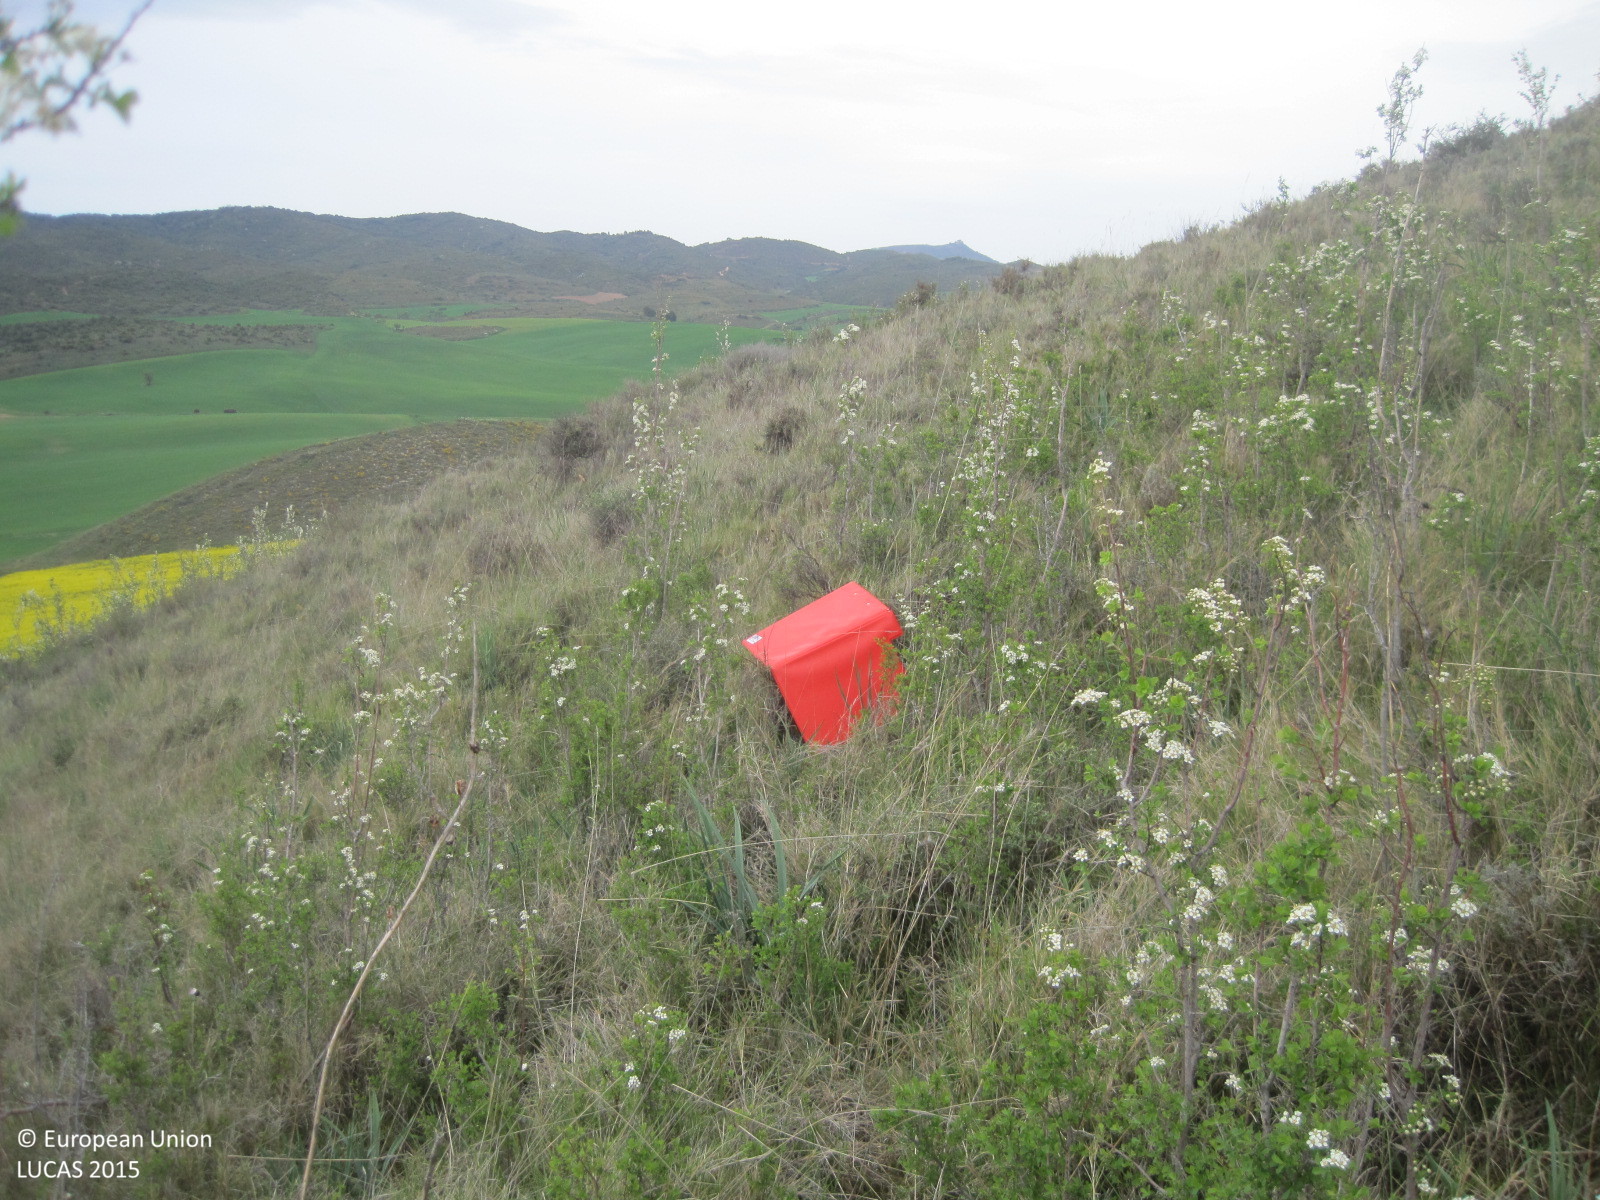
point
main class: Shrubland
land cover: Shrubland without tree cover
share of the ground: > 75 %
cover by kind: shrubs 70 %, herbaceous plants 30 %
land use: Semi-natural and natural areas not in use
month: April
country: ES
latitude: 42.5894
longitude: -2.1924
